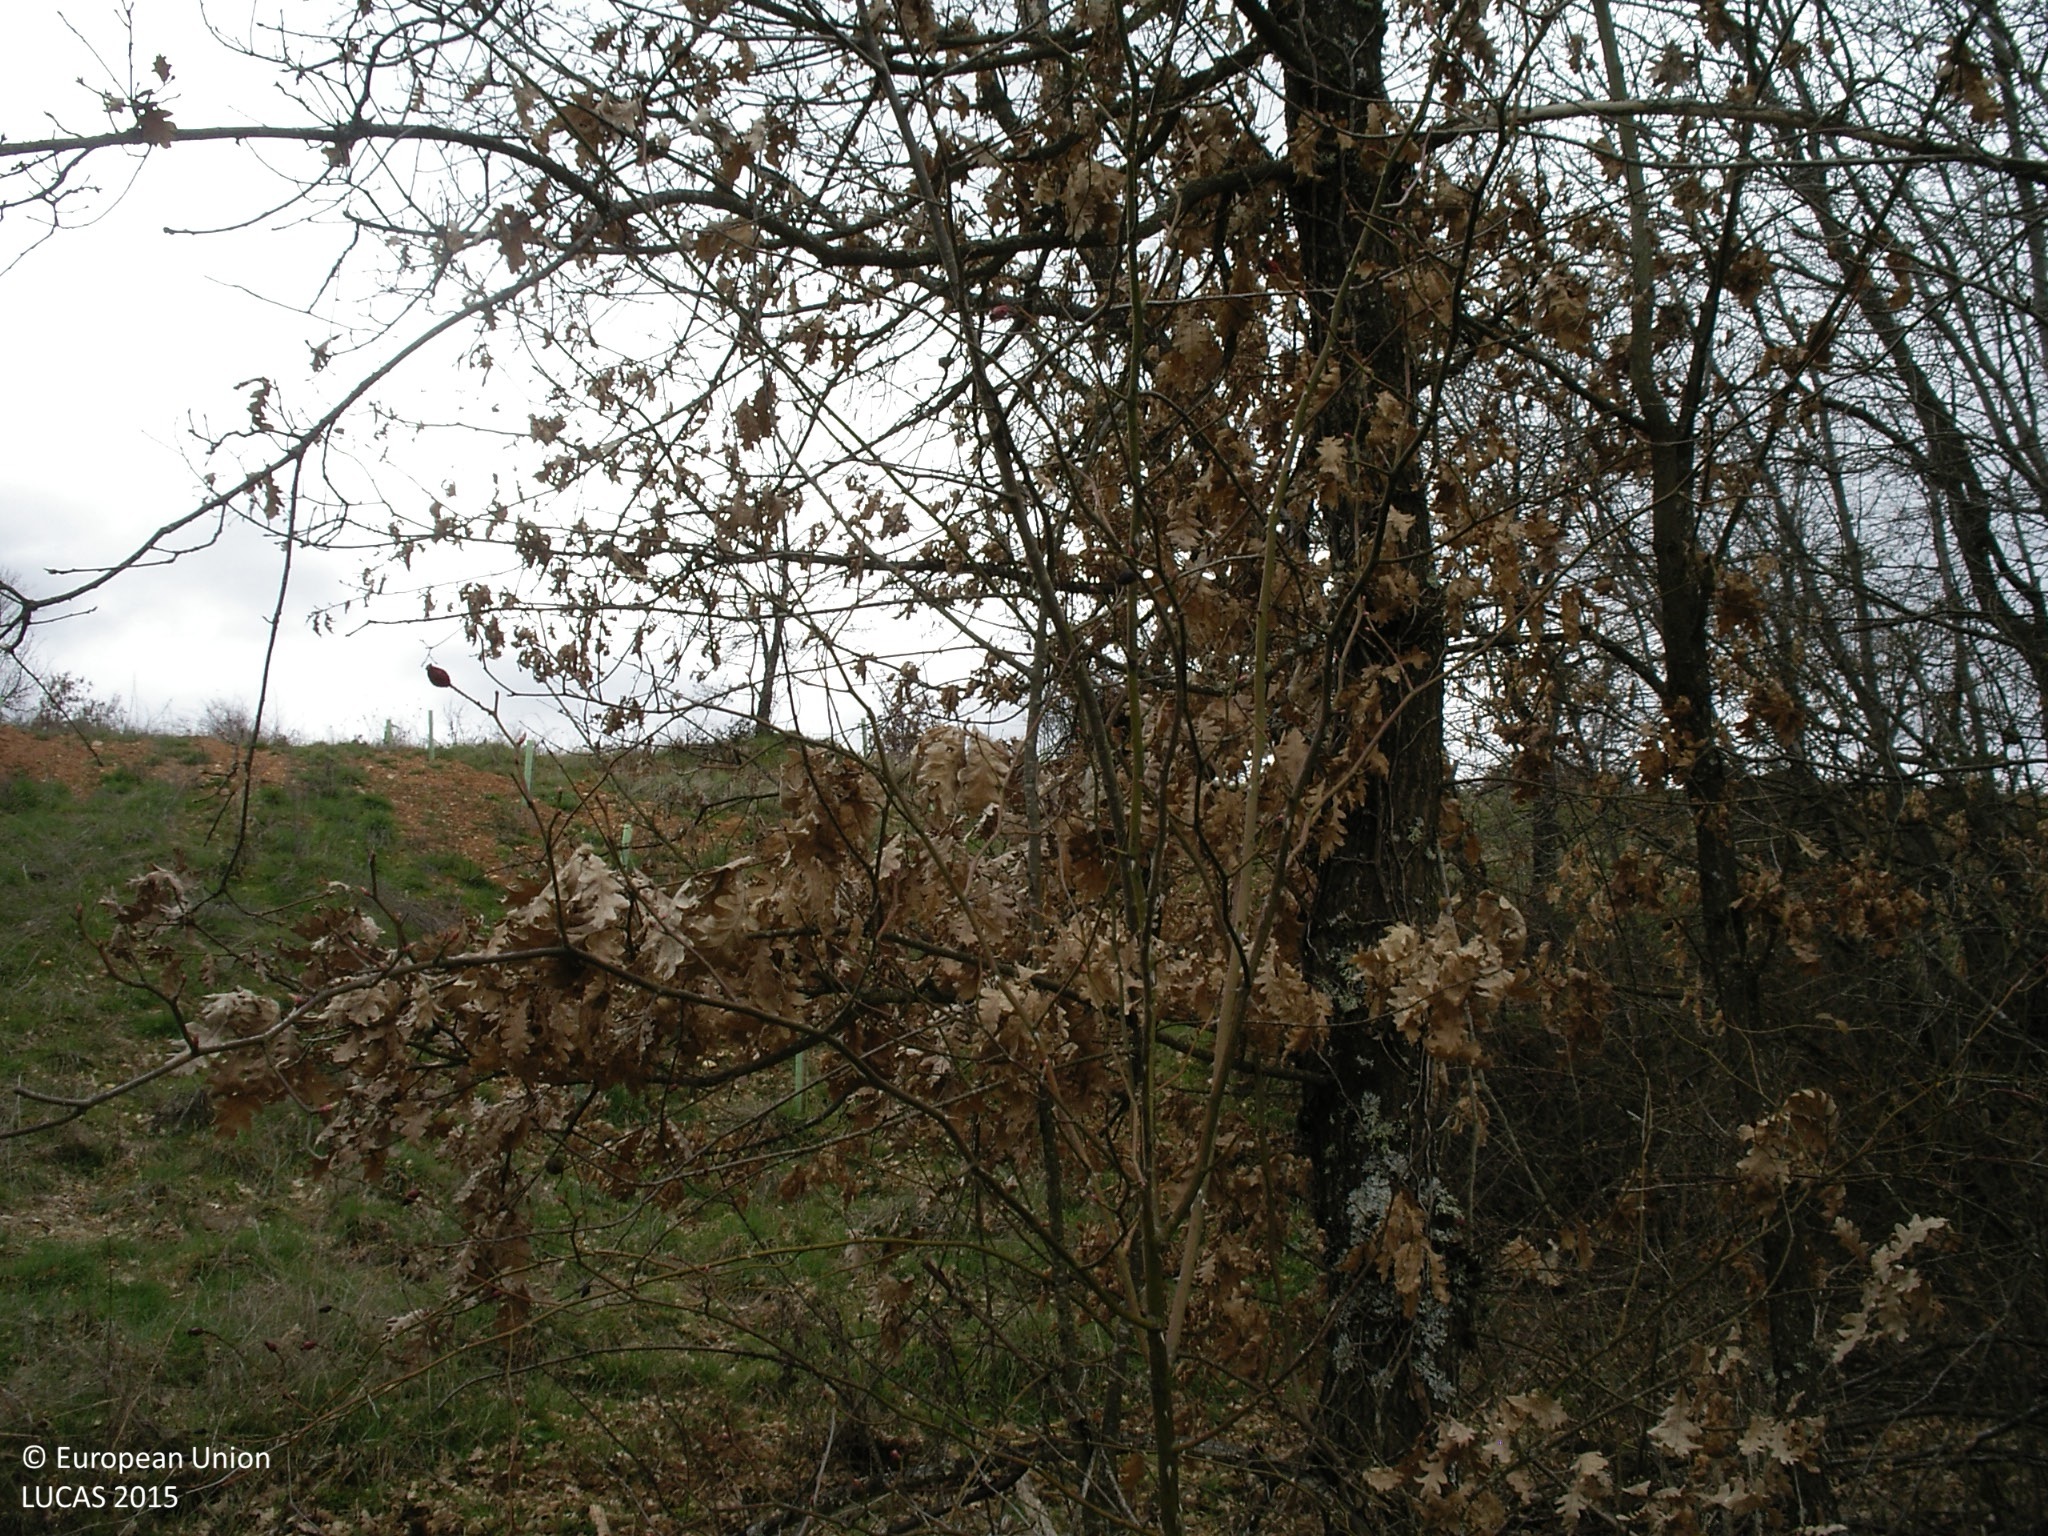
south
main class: Woodland
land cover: Broadleaved woodland
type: thermophilous deciduous forest
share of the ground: 25 - 50 %
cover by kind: herbaceous plants 55 %, broadleaved forest trees 30 %, shrubs 15 %
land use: Forestry
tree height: > 5 m
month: March
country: ES
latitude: 42.6411
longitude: -6.4477
